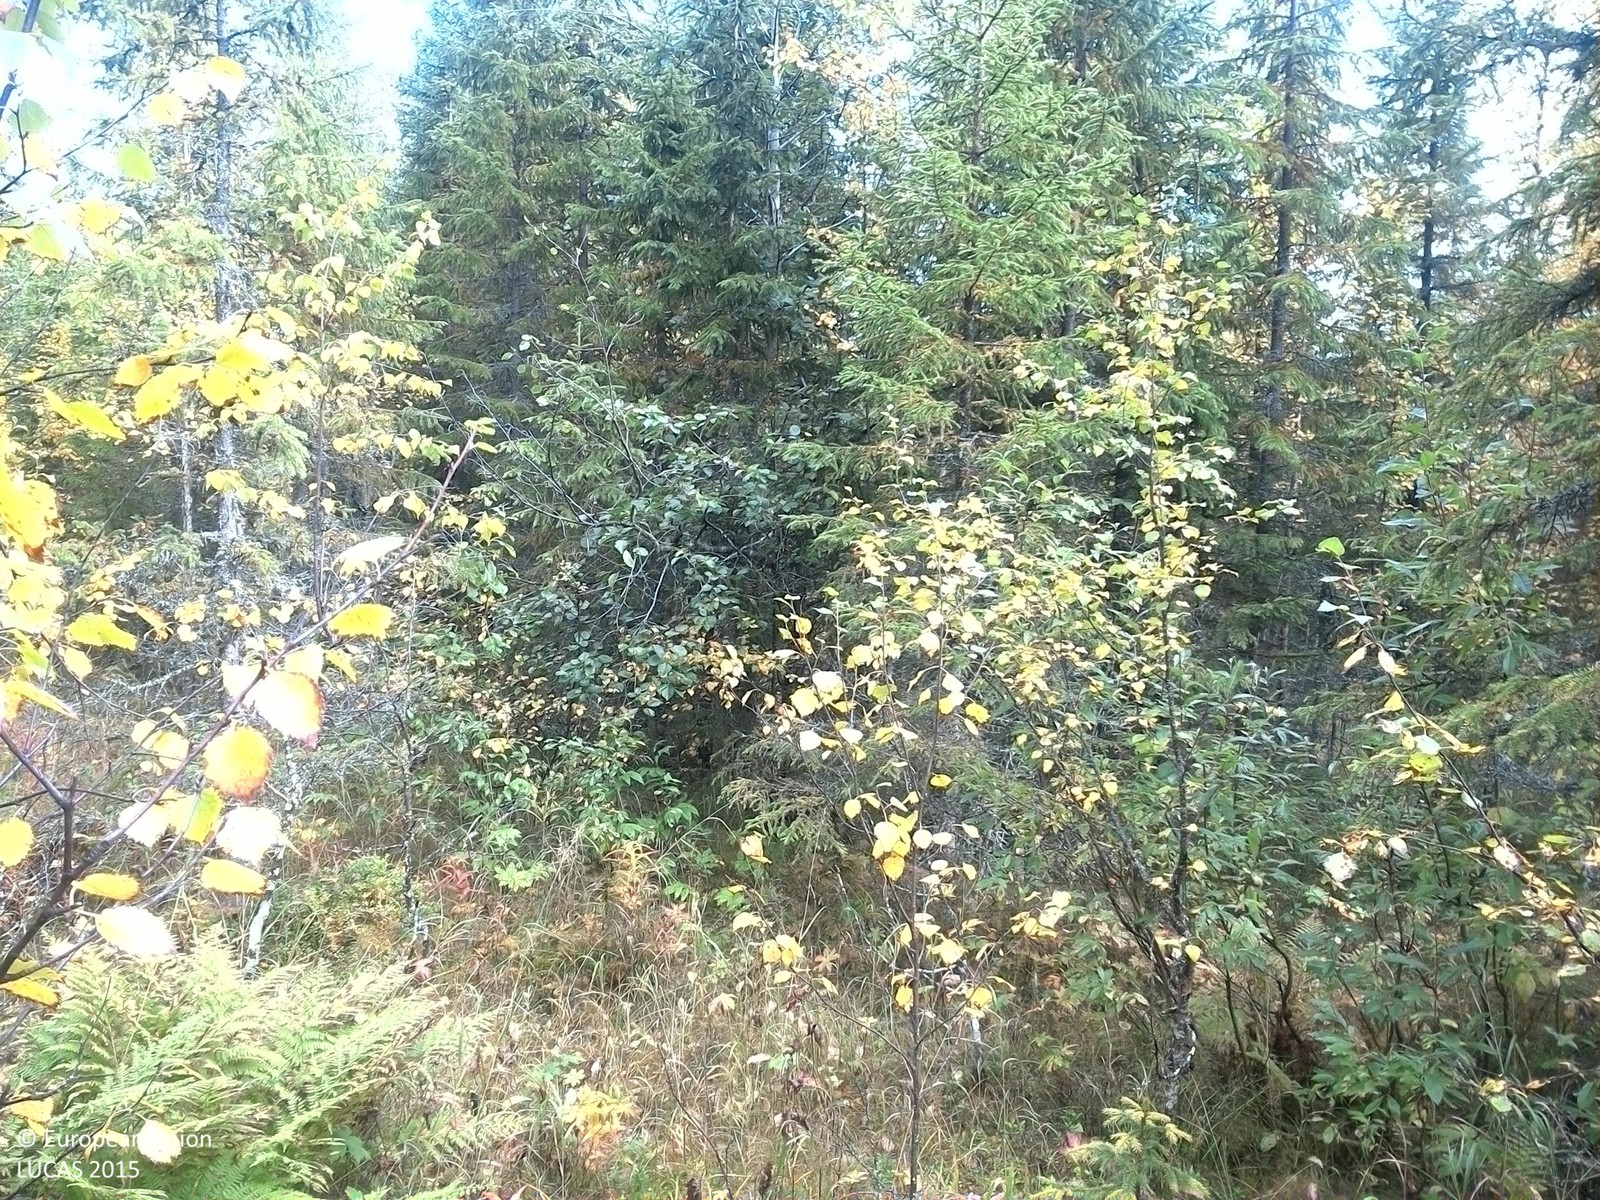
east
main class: Woodland
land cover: Spruce dominated mixed woodland
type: boreal forest
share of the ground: > 75 %
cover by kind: coniferous forest trees 55 %, broadleaved forest trees 20 %, herbaceous plants 15 %, shrubs 5 %, lichens and mosses 5 %
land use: Forestry
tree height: > 5 m
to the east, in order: Spruce dominated mixed woodland
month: September
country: SE
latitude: 63.5817
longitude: 15.9169
